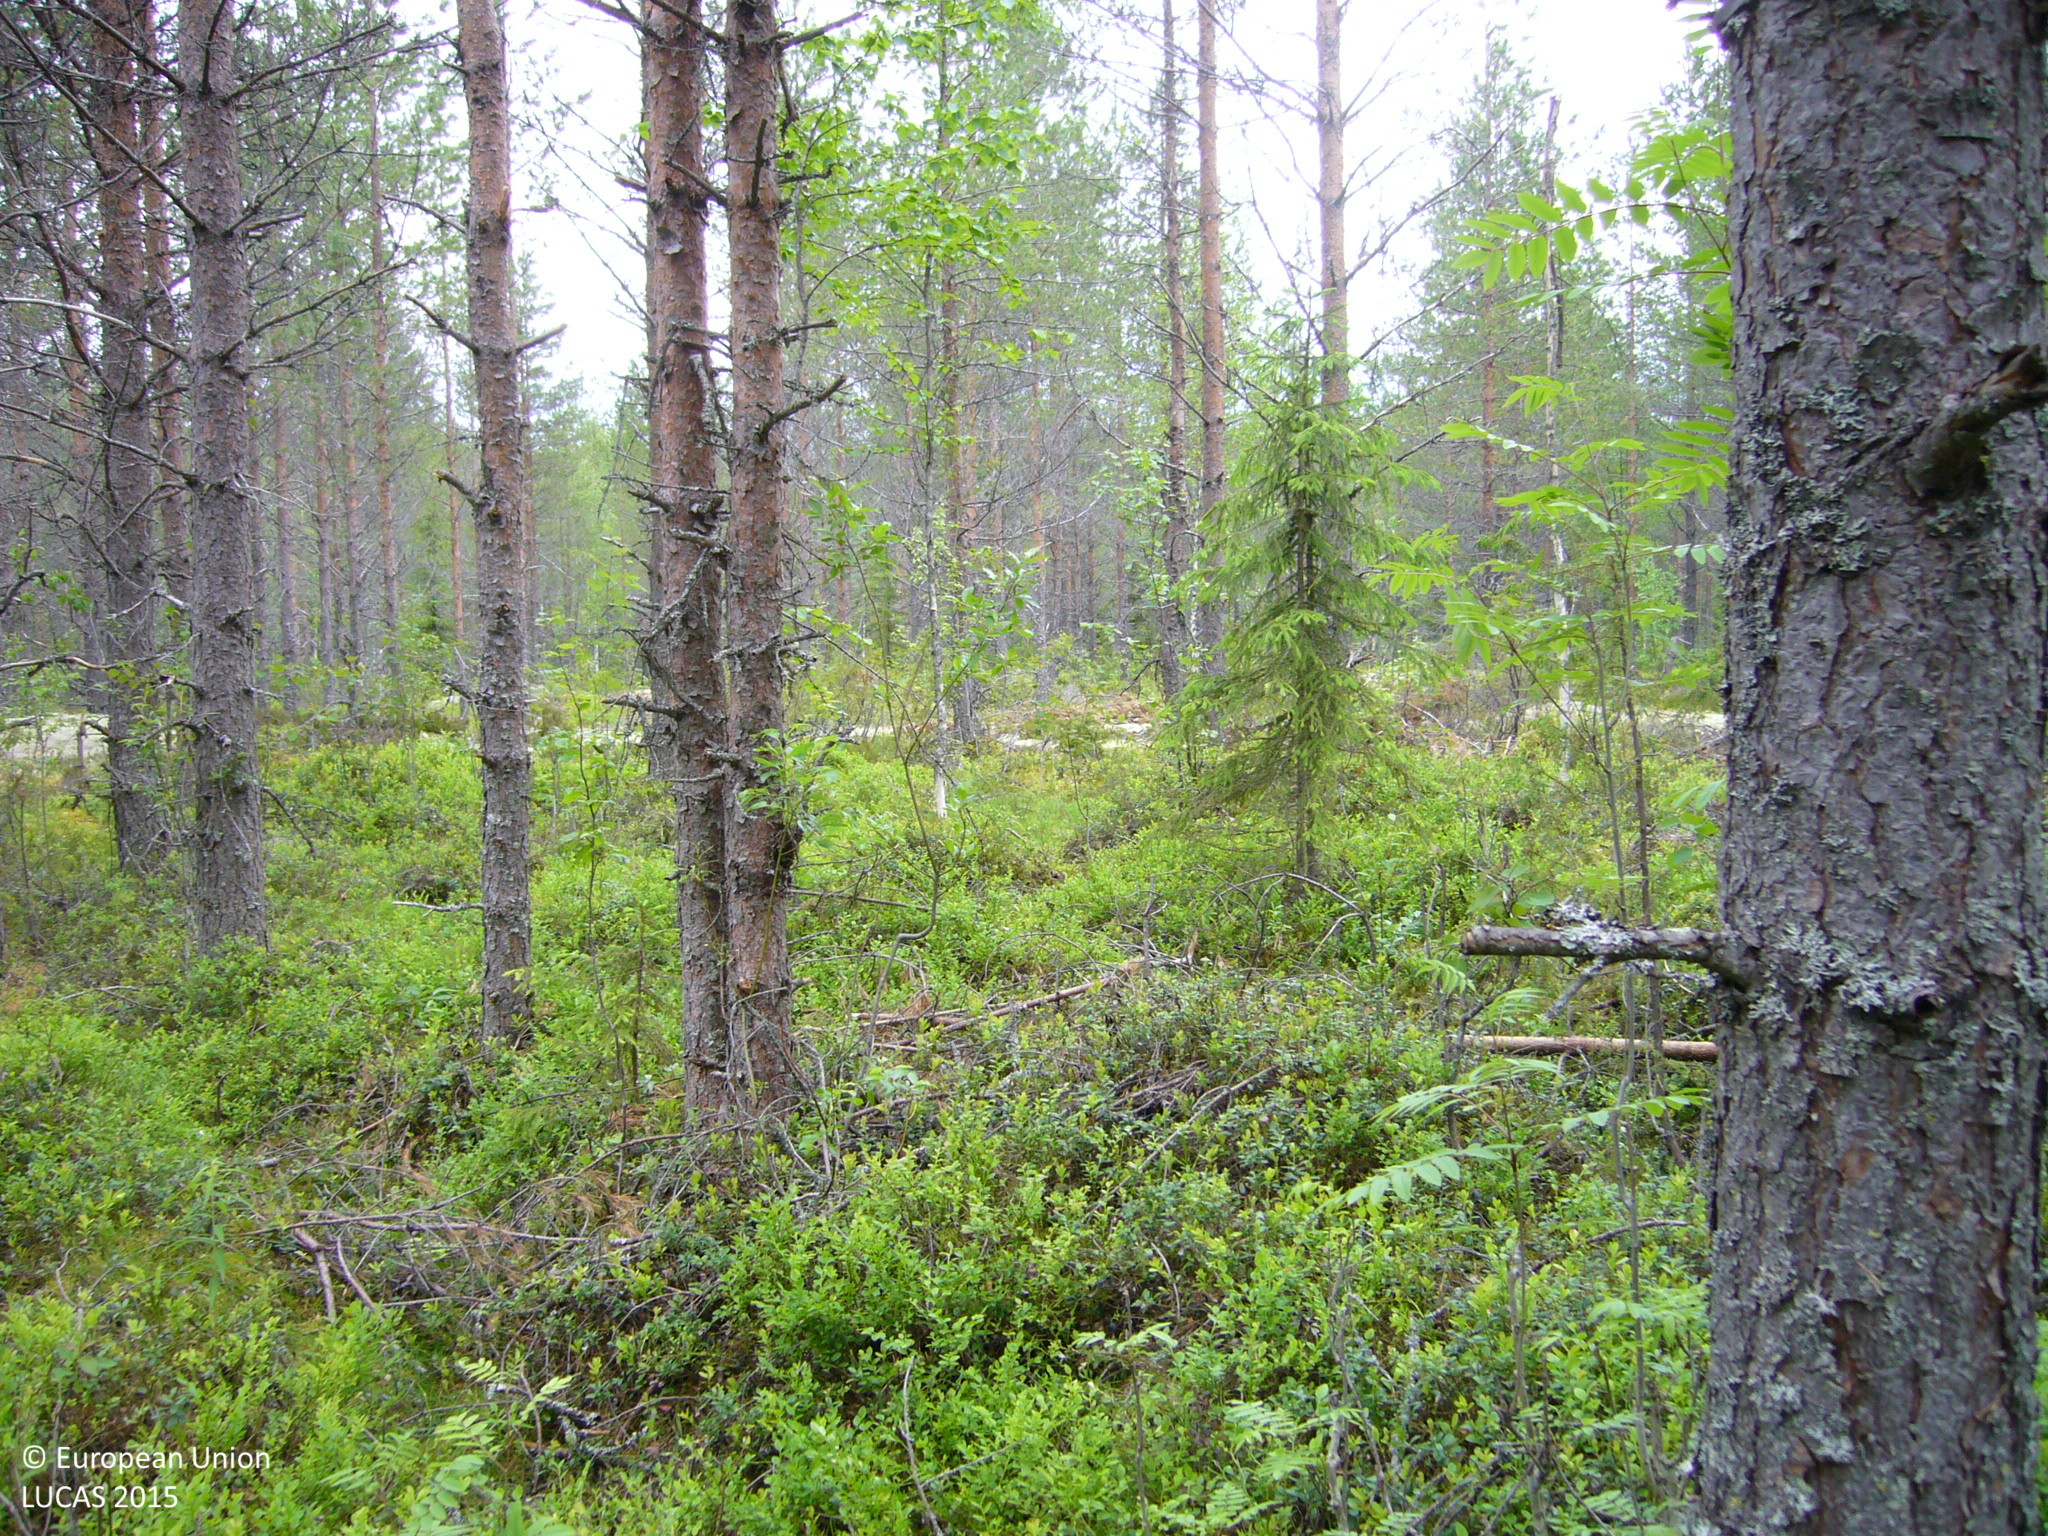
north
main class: Woodland
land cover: Pine dominated coniferous woodland
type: boreal forest
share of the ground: 50 - 75 %
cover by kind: coniferous forest trees 60 %, shrubs 35 %, broadleaved forest trees 5 %
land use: Forestry
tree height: > 5 m
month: June
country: FI
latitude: 63.7875
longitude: 26.1237
